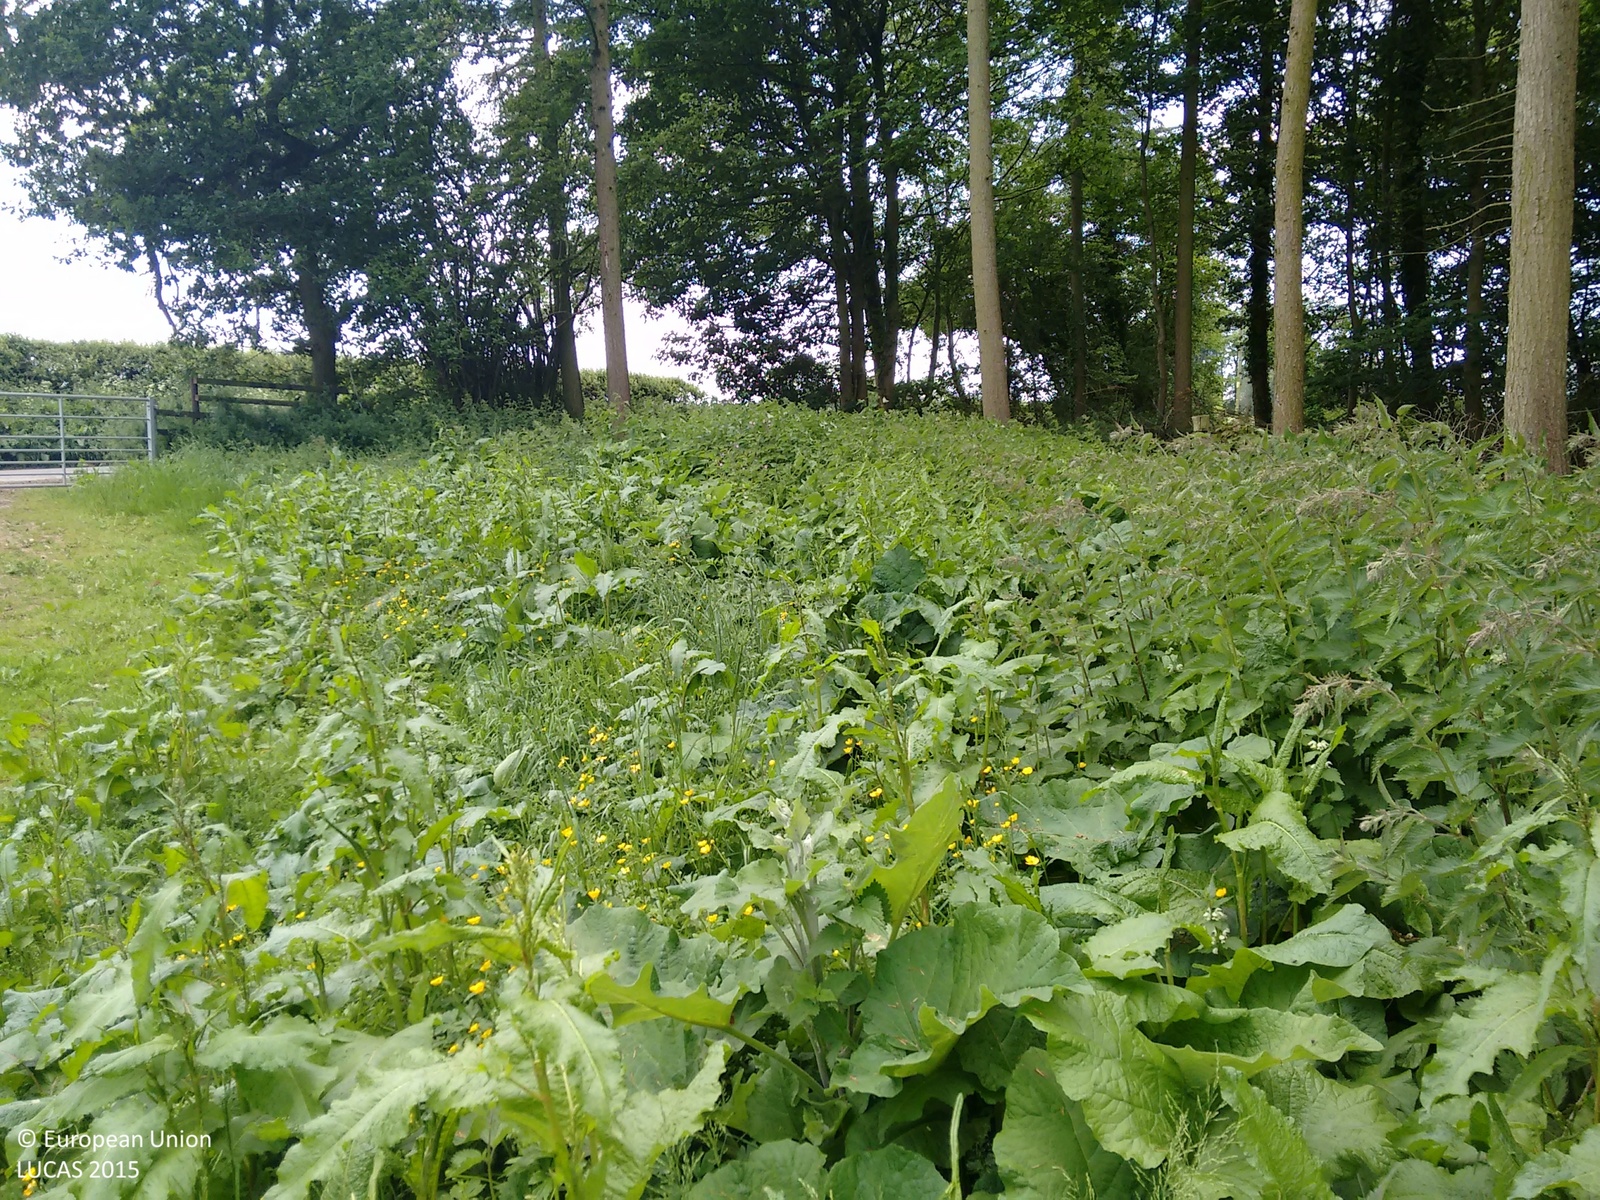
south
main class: Woodland
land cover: Broadleaved woodland
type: mesophytic deciduous forest
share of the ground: > 75 %
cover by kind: broadleaved forest trees 80 %, coniferous forest trees 20 %
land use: Semi-natural and natural areas not in use
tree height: > 5 m
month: June
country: GB
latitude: 51.0628
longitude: -2.1175
